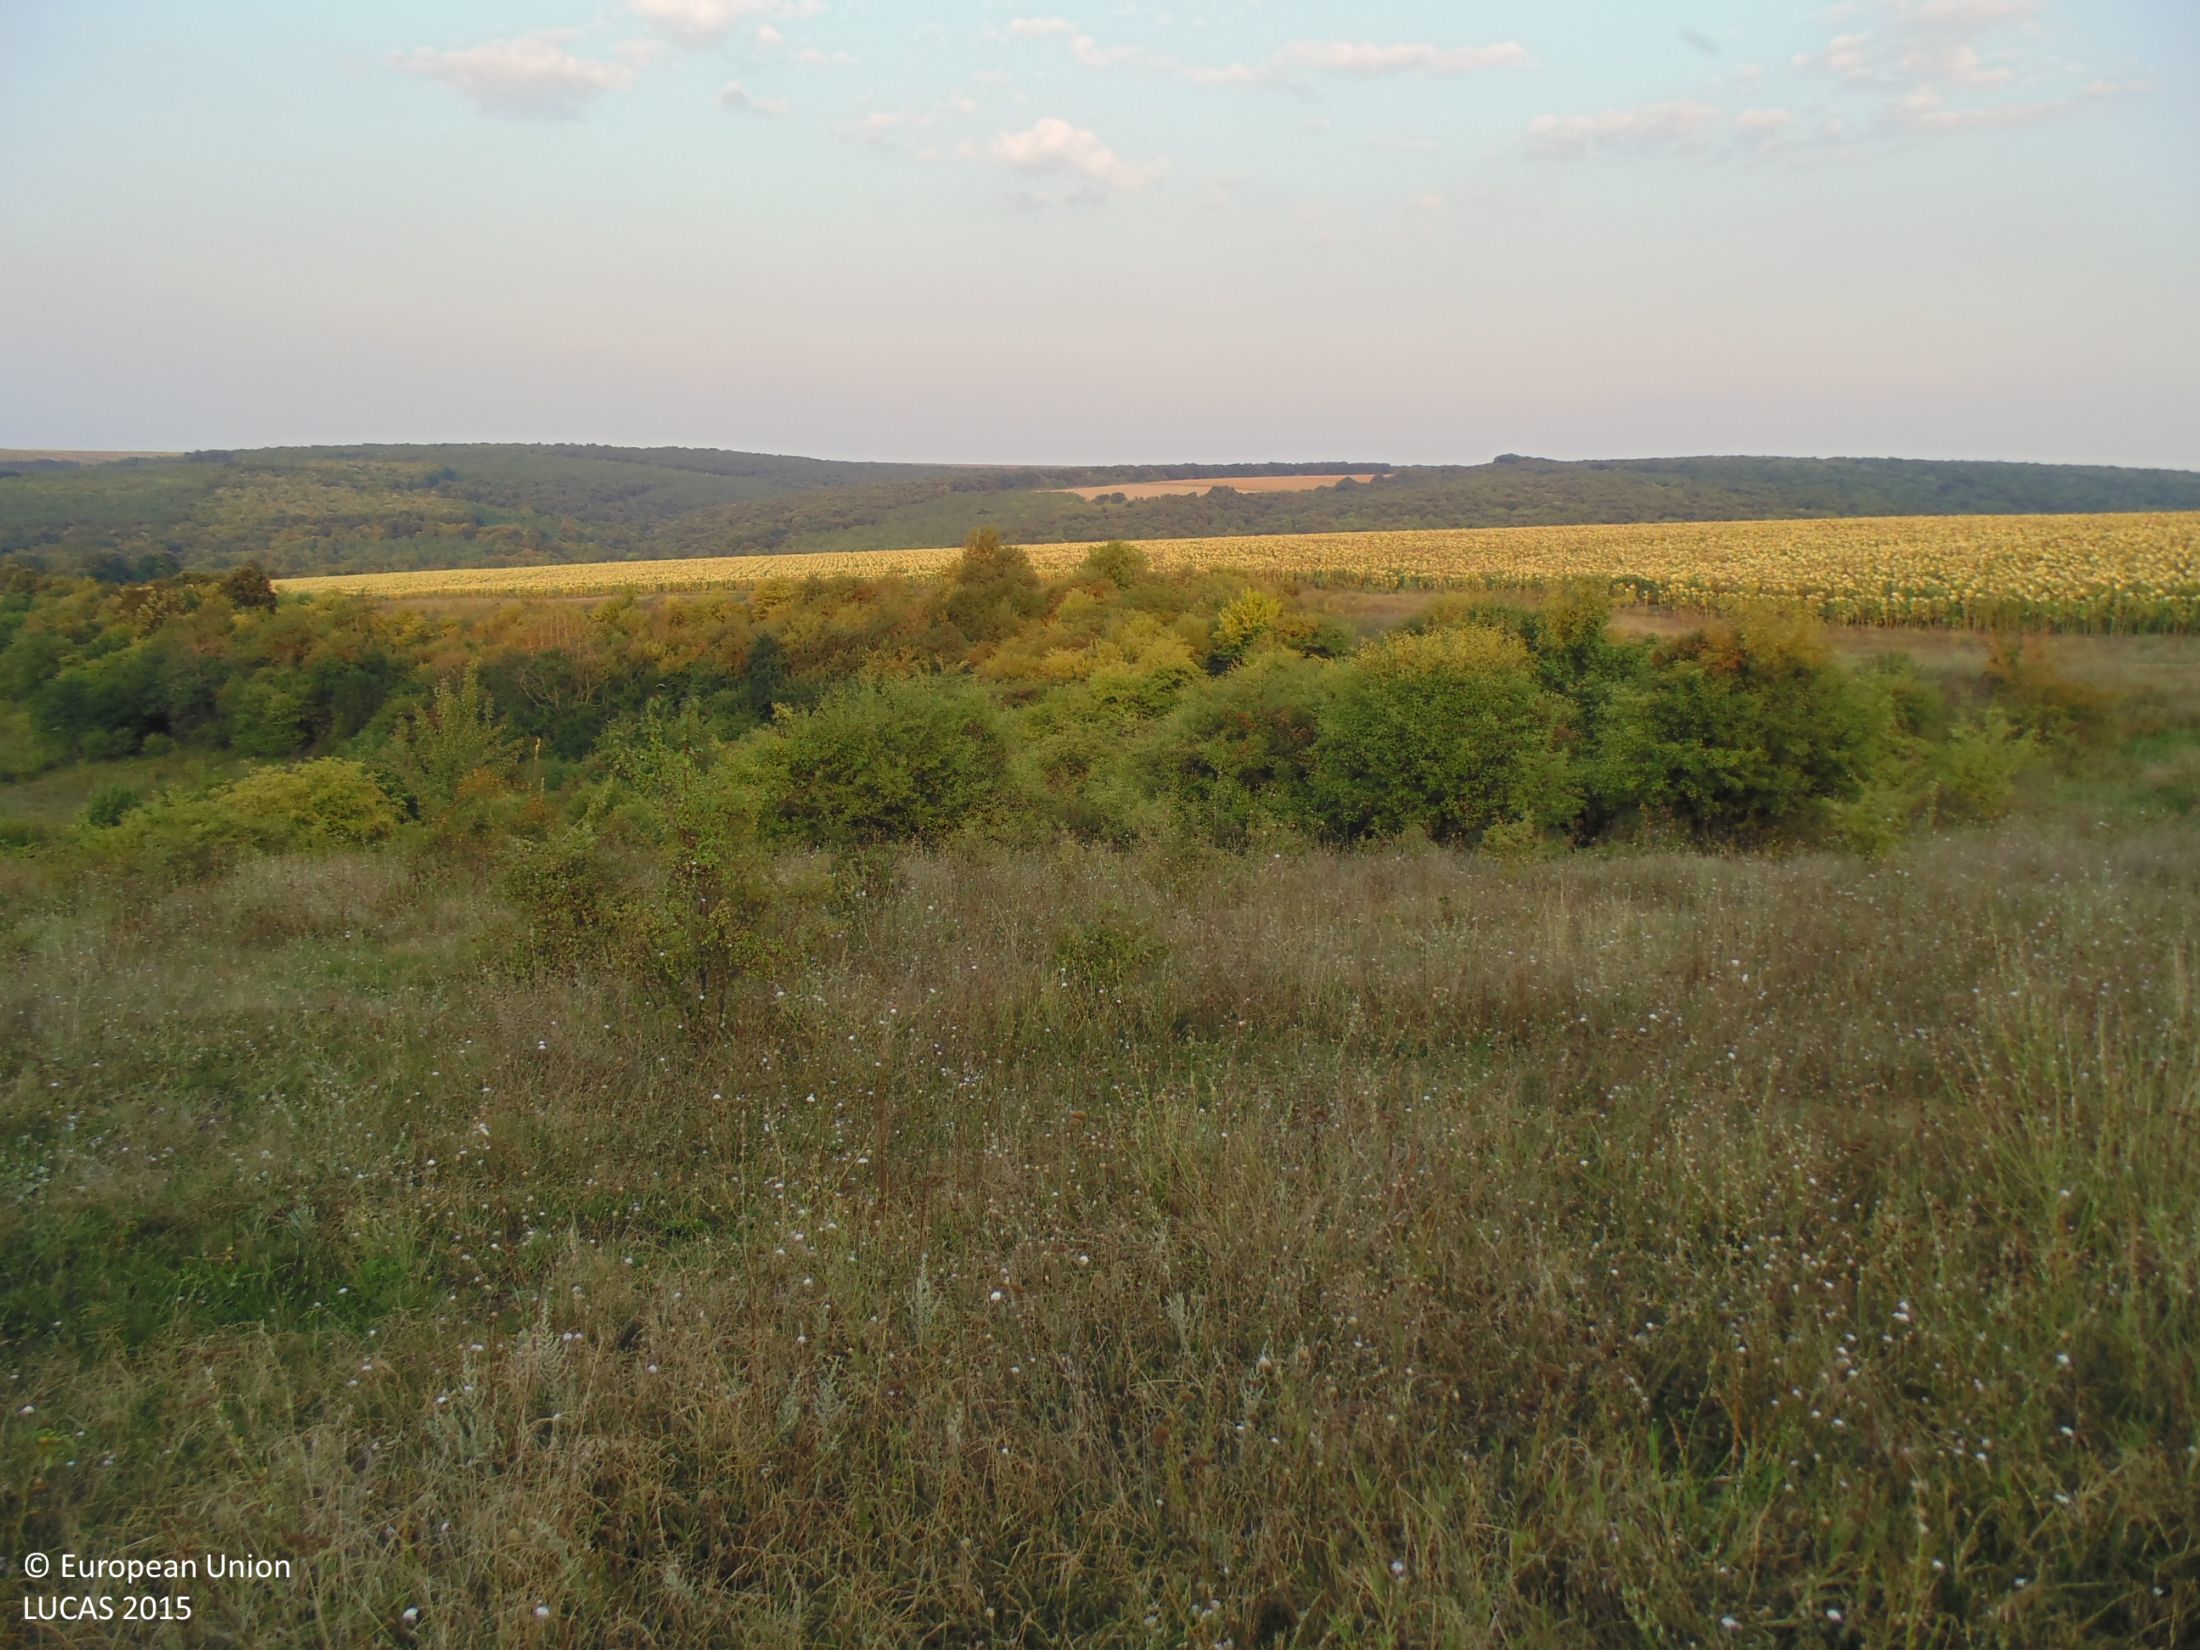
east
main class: Grassland
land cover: Grassland with sparse tree/shrub cover
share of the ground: > 75 %
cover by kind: herbaceous plants 90 %, broadleaved forest trees 5 %, shrubs 5 %
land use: Agriculture (excluding fallow land and kitchen gardens)
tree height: < 5 m
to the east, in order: Grassland with sparse tree/shrub cover; Broadleaved woodland; Grassland with sparse tree/shrub cover; Sunflower
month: August
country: BG
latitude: 43.8455
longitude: 27.3844
